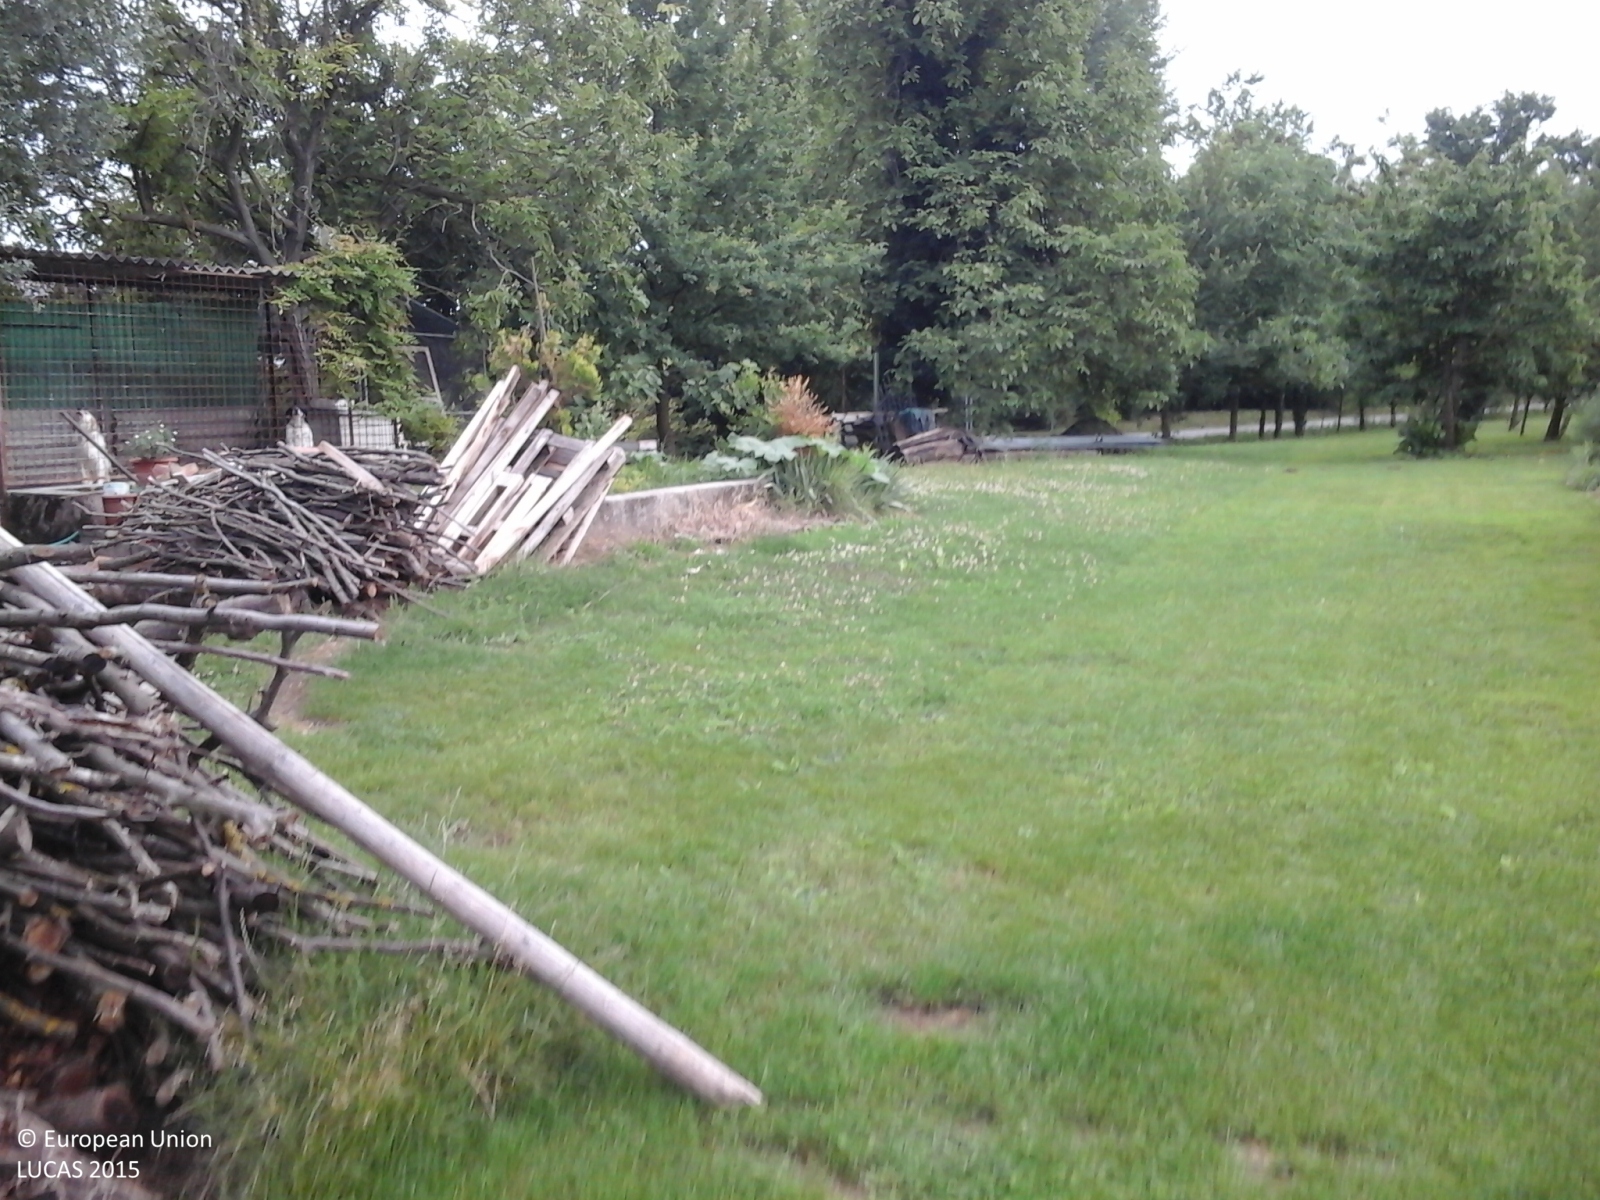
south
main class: Grassland
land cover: Grassland without tree/shrub cover
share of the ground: > 75 %
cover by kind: herbaceous plants 100 %
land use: Residential
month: June
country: IT
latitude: 45.8556
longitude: 12.4051
